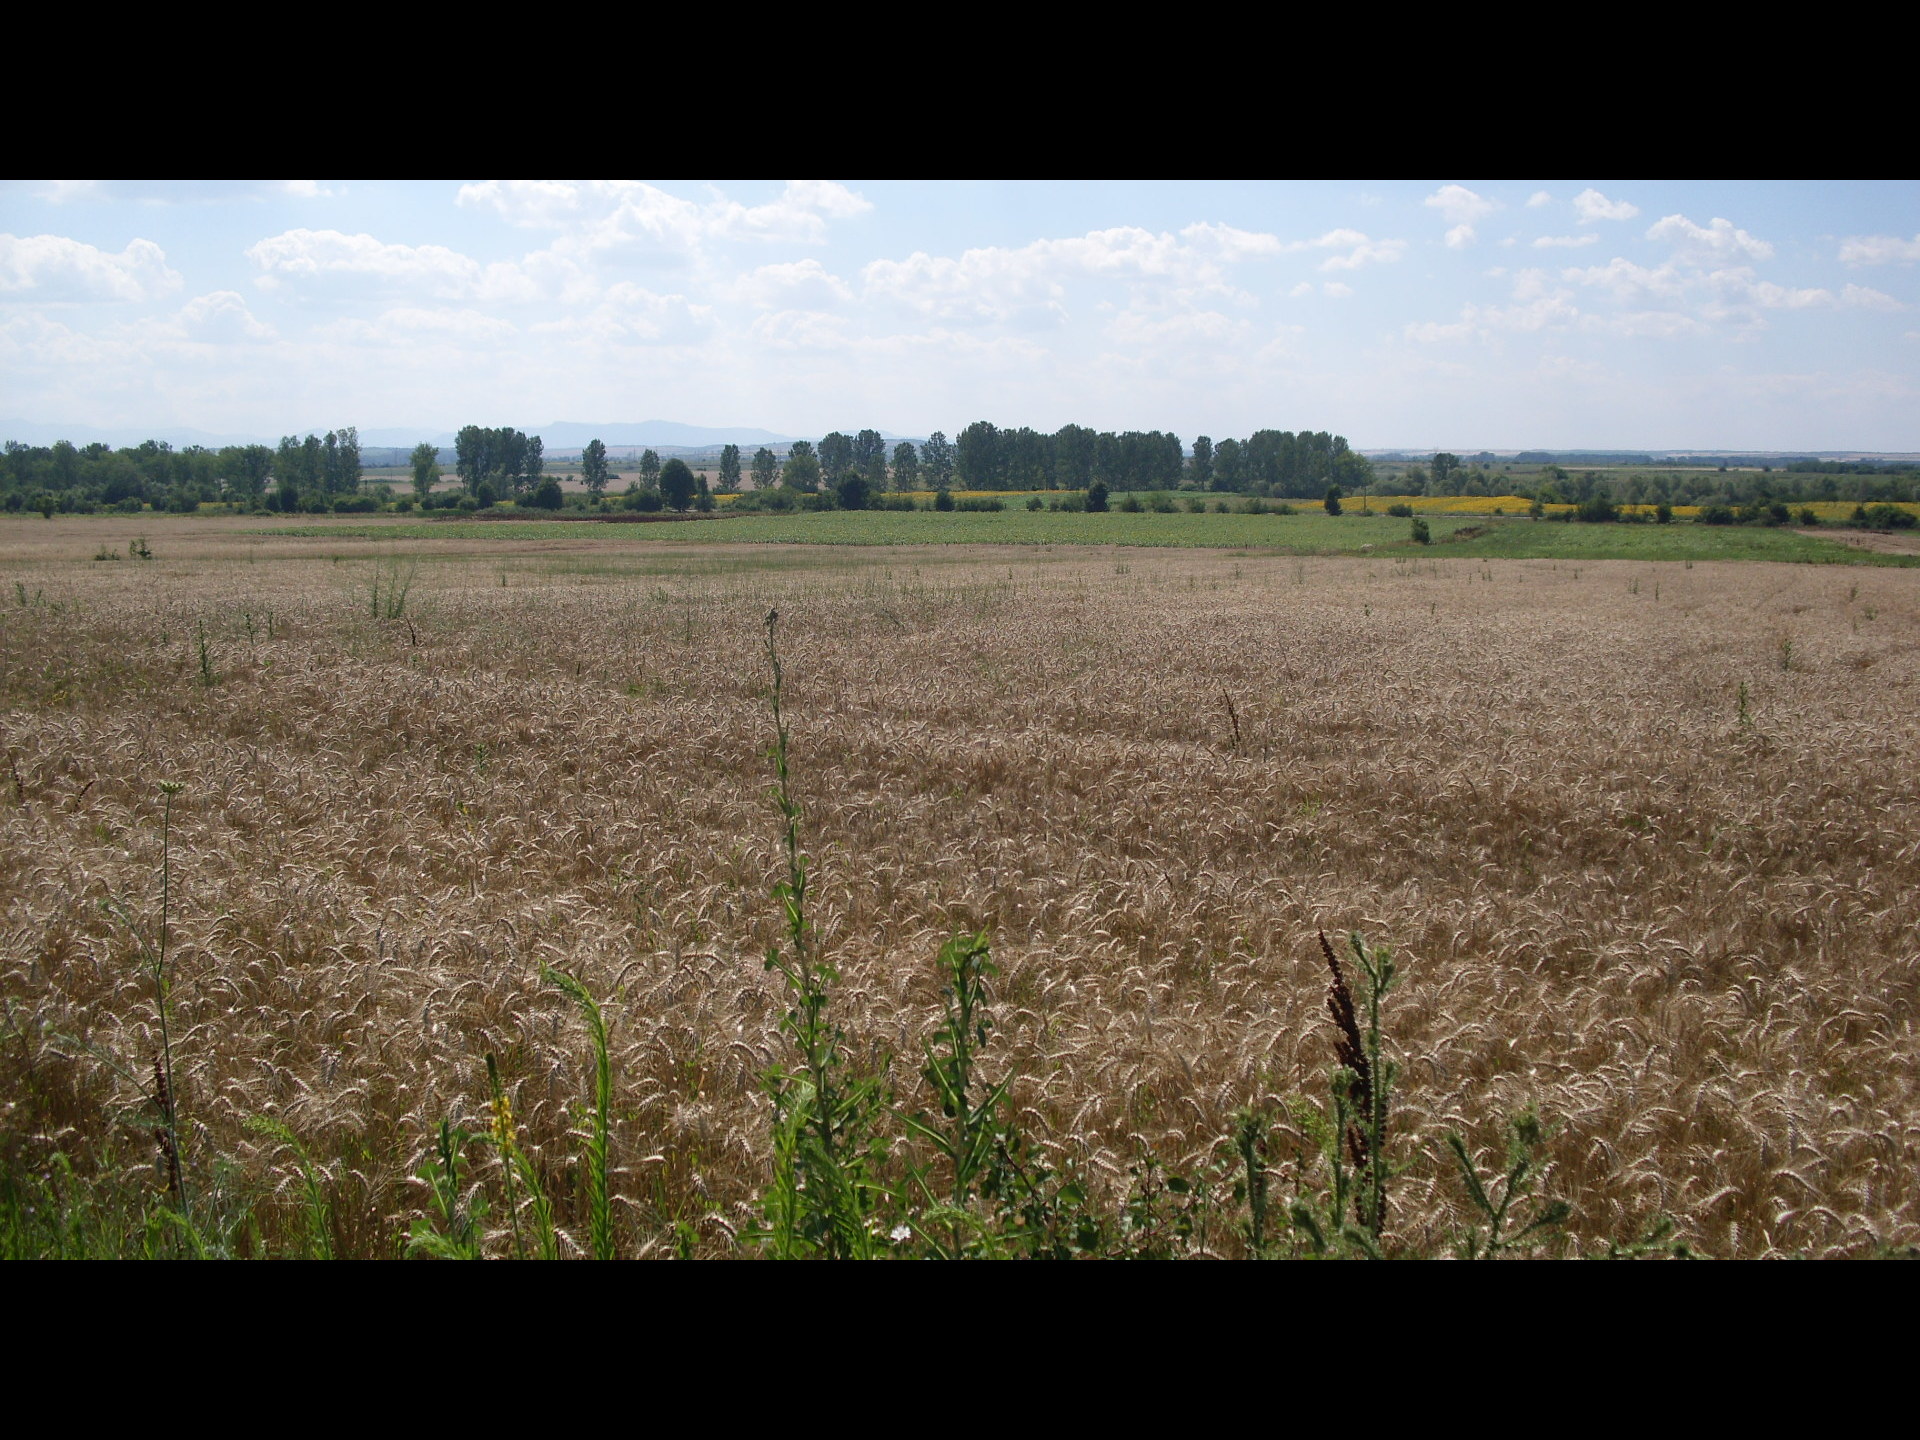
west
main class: Grassland
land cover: Spontaneously vegetated surfaces
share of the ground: > 75 %
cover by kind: herbaceous plants 100 %
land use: Agriculture (excluding fallow land and kitchen gardens)
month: July
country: BG
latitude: 43.6801
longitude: 23.1021
